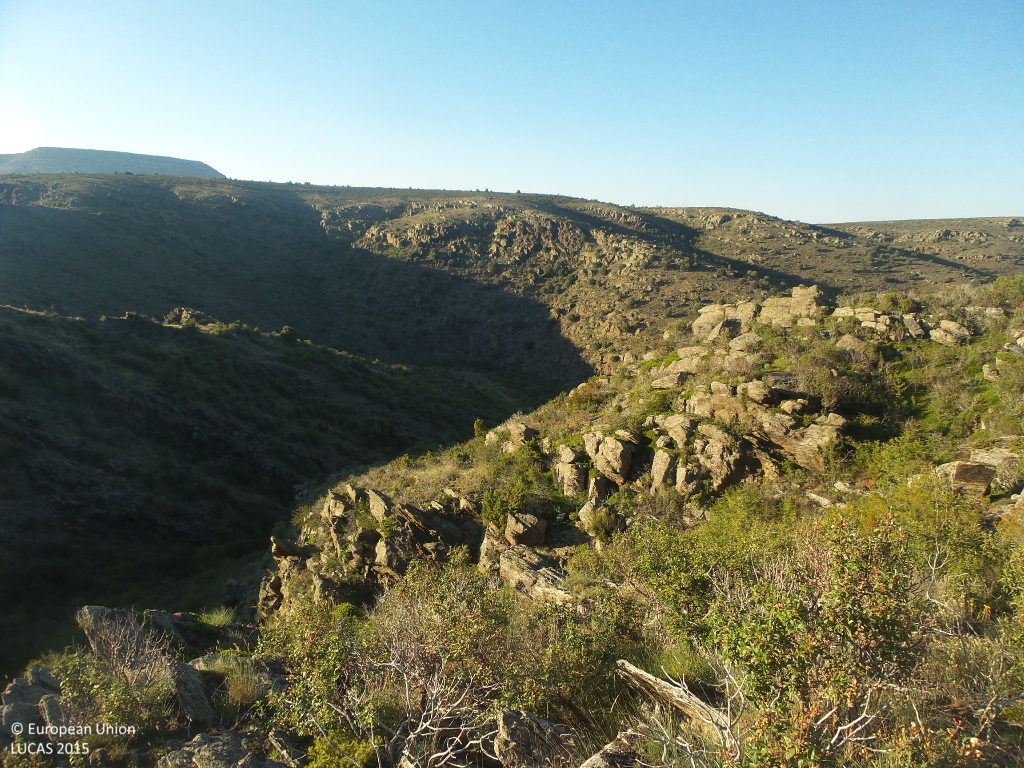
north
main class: Shrubland
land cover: Shrubland without tree cover
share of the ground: 25 - 50 %
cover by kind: shrubs 40 %, consolidated bare surface 40 %, unconsolidated bare surface 20 %
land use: Semi-natural and natural areas not in use
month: June
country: ES
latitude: 41.2058
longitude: -3.0255
